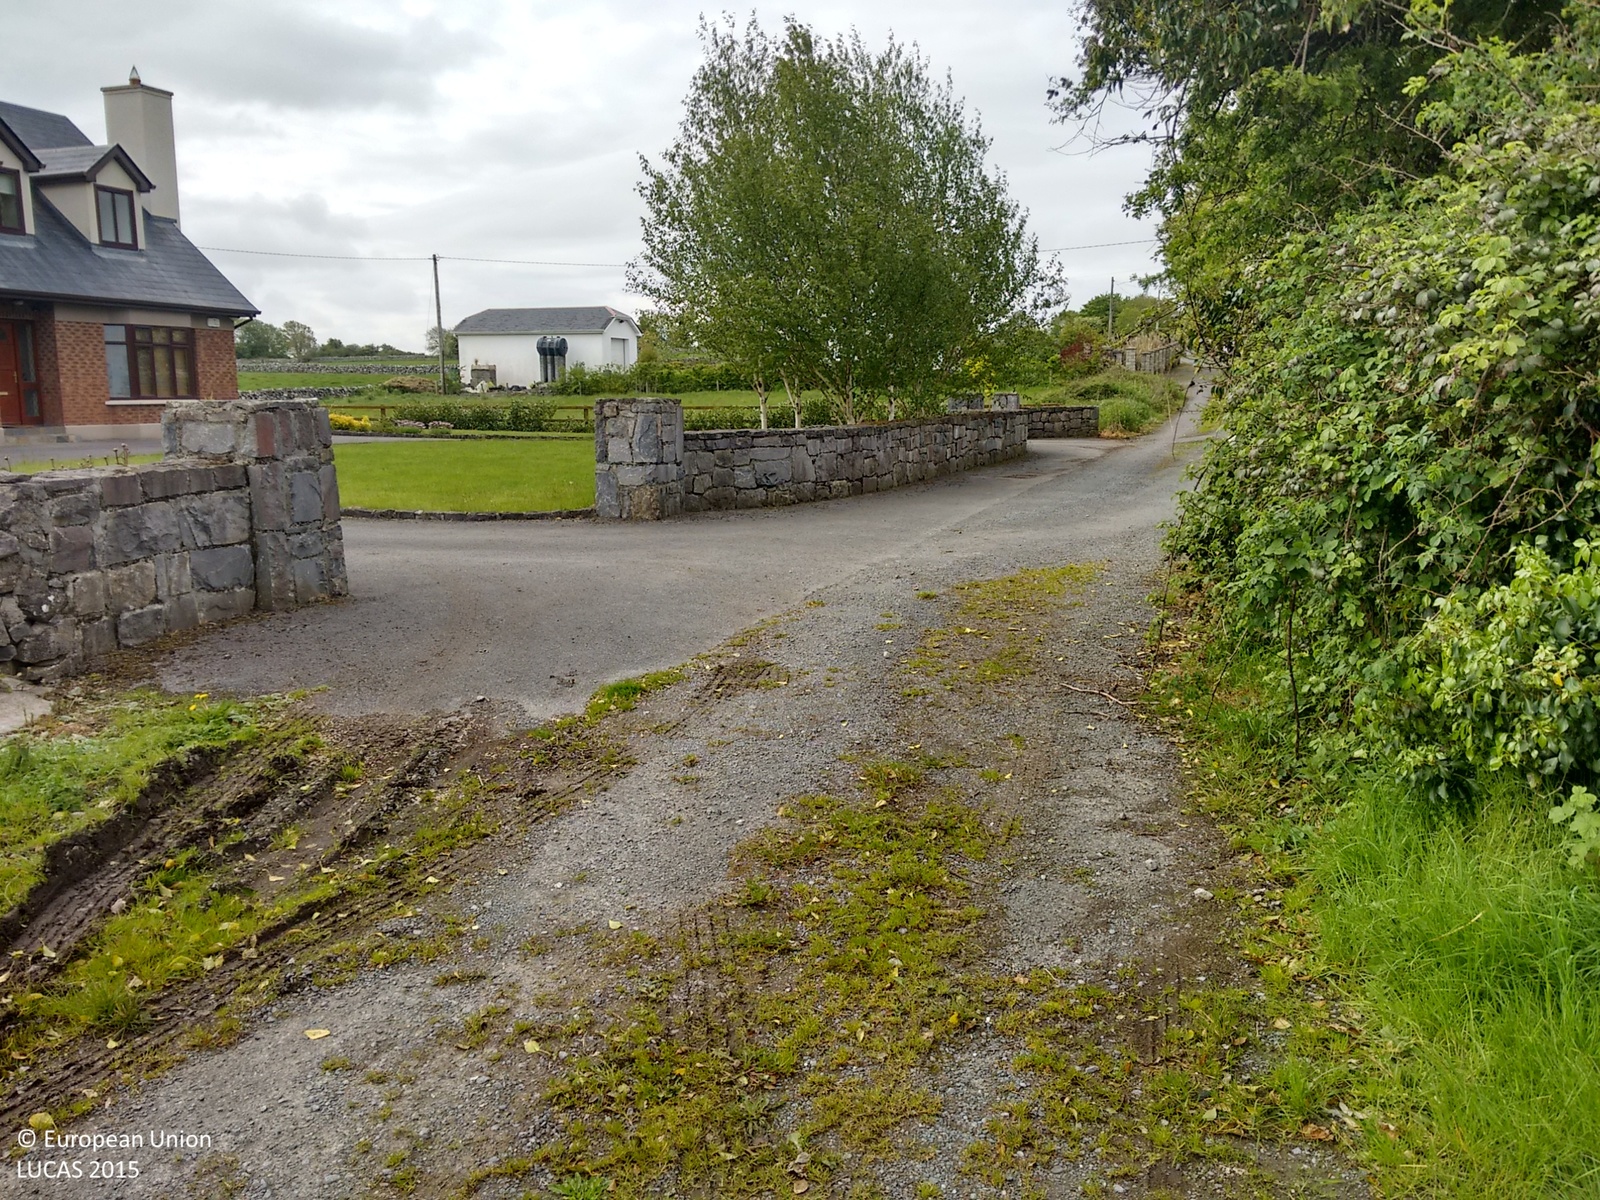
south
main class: Grassland
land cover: Grassland without tree/shrub cover
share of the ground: > 75 %
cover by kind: herbaceous plants 100 %
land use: Agriculture (excluding fallow land and kitchen gardens)
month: May
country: IE
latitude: 53.3307
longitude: -8.9345
